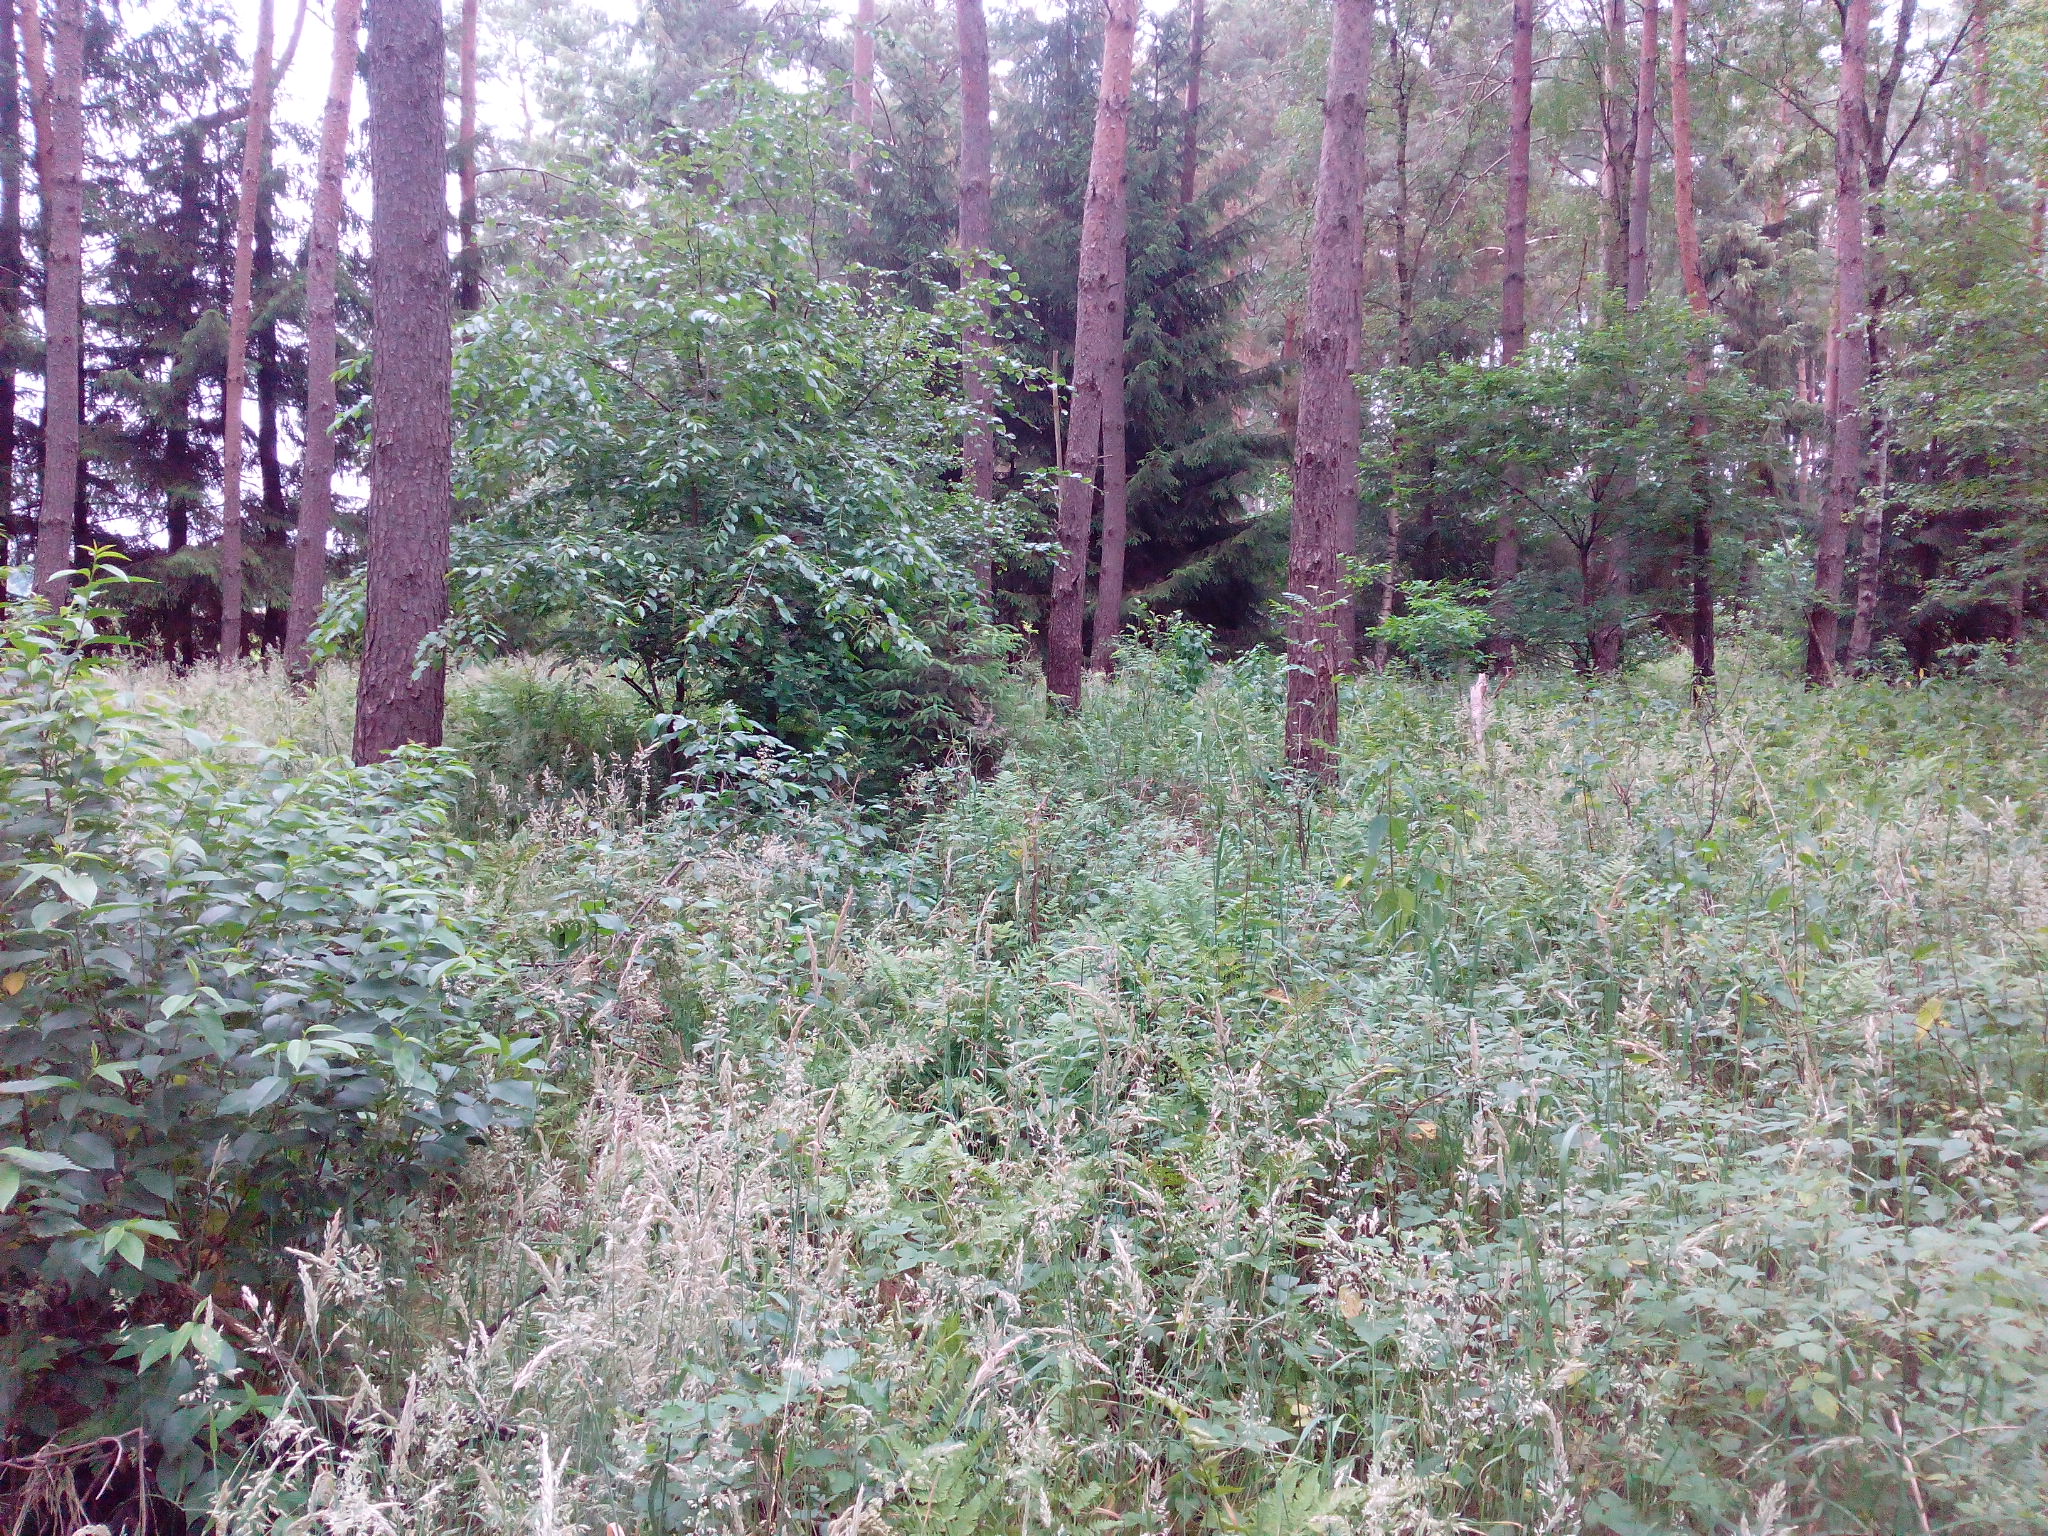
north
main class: Woodland
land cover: Pine dominated coniferous woodland
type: hemiboreal forest and nemoral coniferous forest and mixed broadleaved-coniferous forest
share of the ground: > 75 %
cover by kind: coniferous forest trees 80 %, herbaceous plants 10 %, broadleaved forest trees 5 %, shrubs 5 %
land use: Forestry
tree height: > 5 m
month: June
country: DE
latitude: 52.6110
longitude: 9.8671
